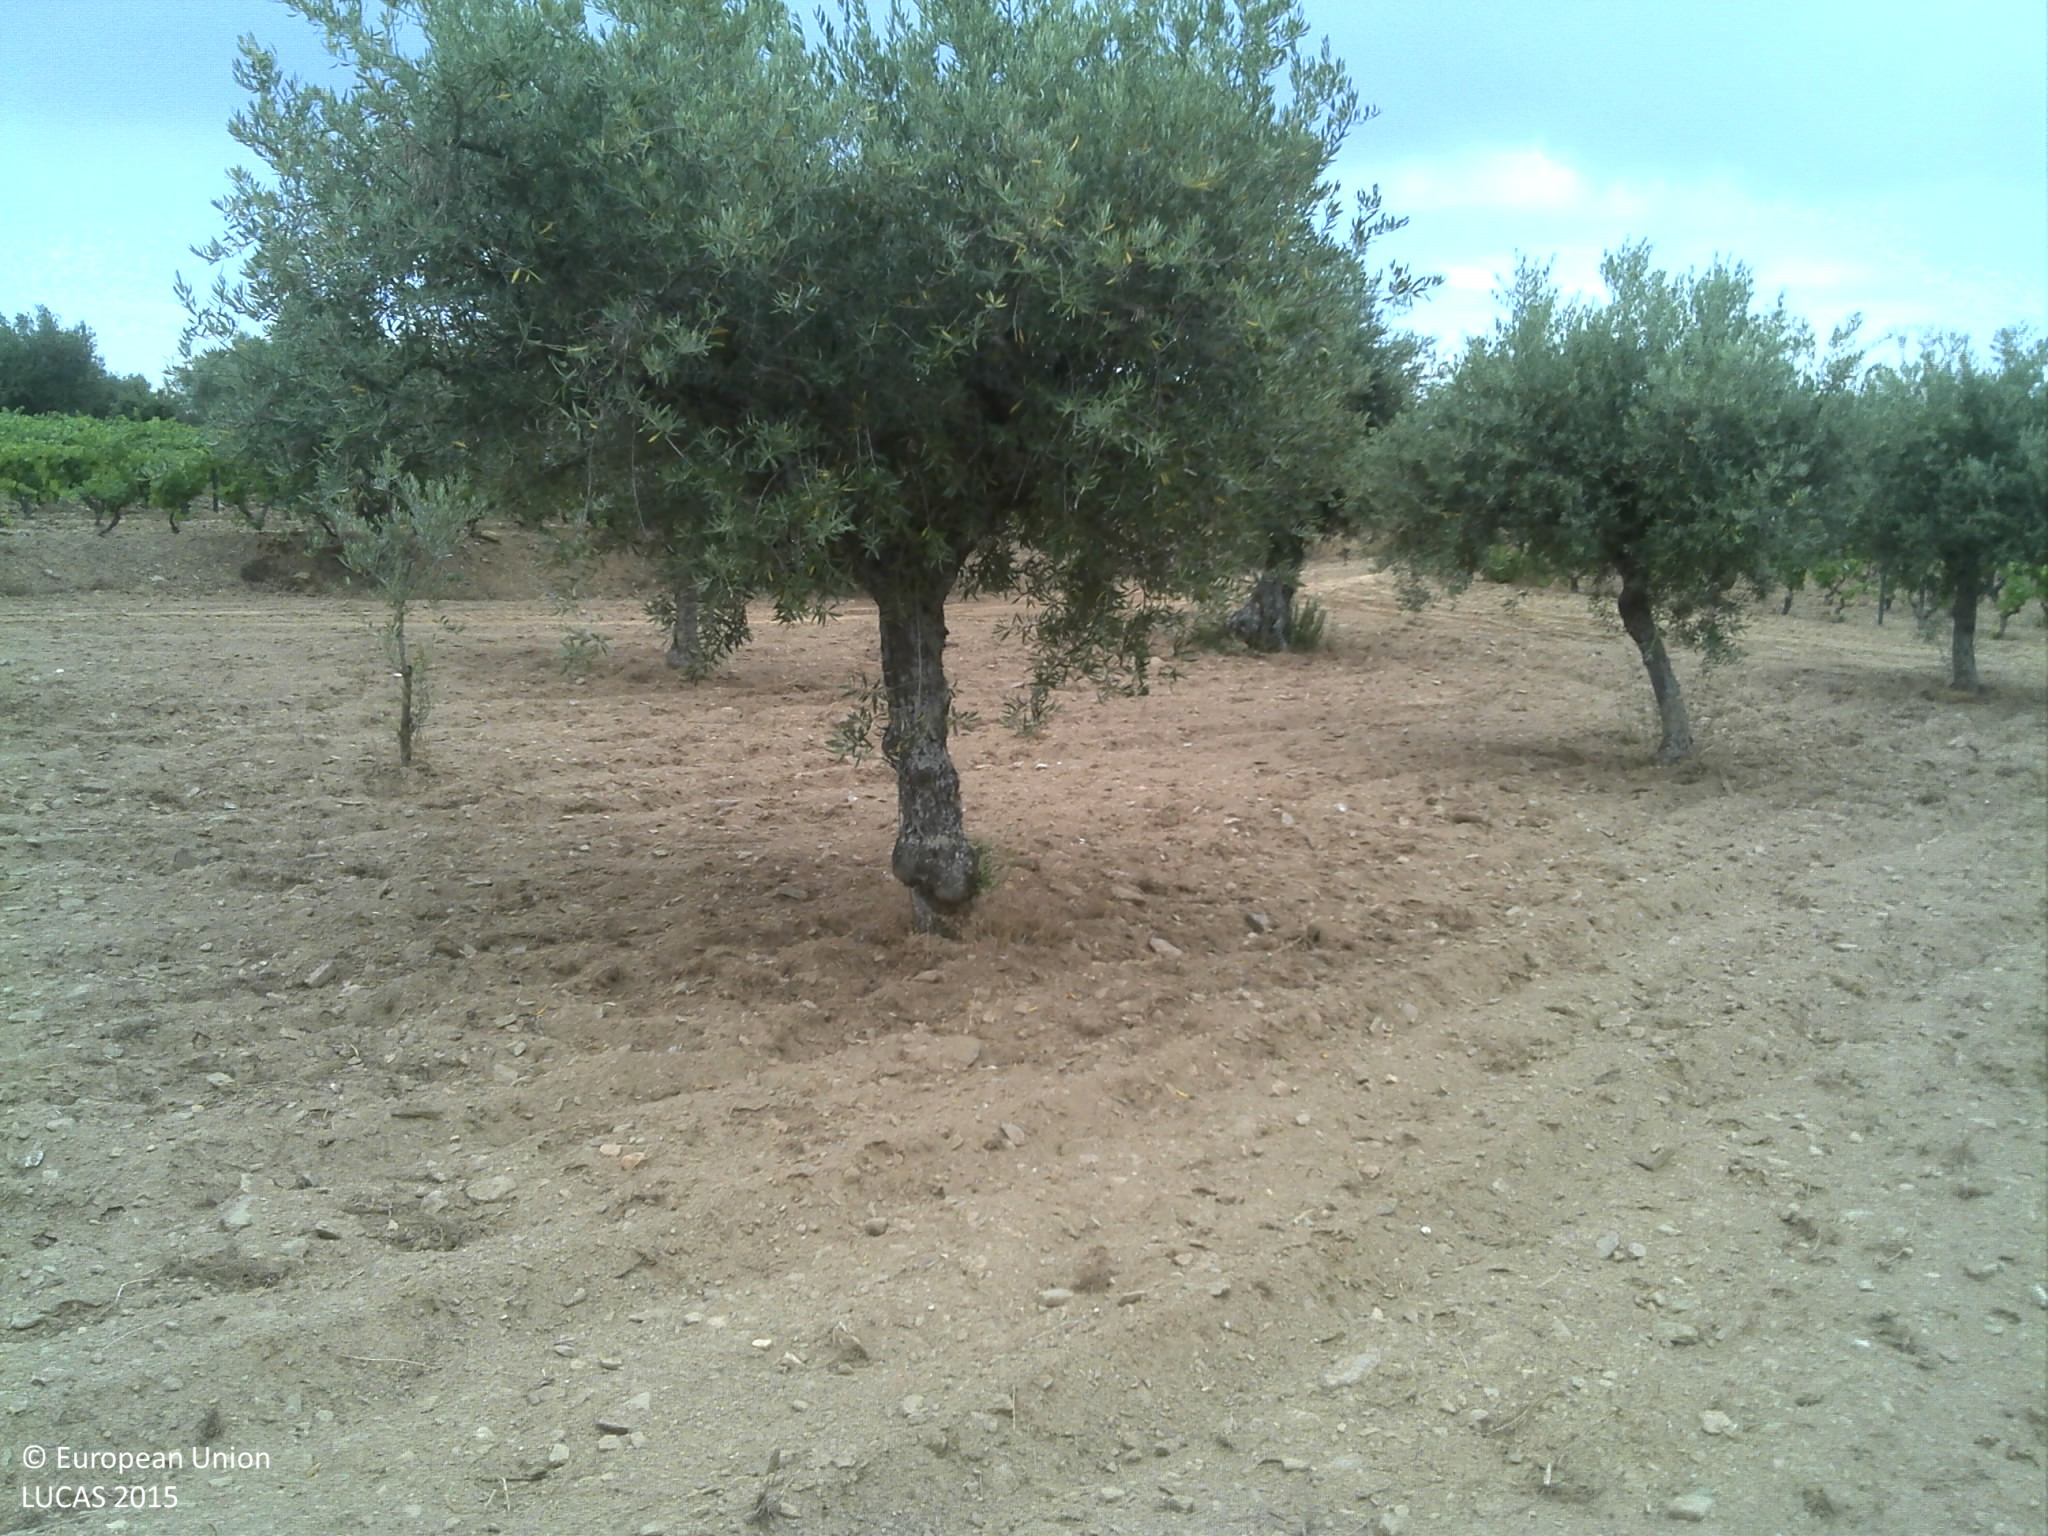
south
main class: Cropland
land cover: Olive groves
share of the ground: < 10 %
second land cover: Other bare soil
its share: > 75 %
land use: Agriculture (excluding fallow land and kitchen gardens)
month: July
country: PT
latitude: 41.0488
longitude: -7.2579
